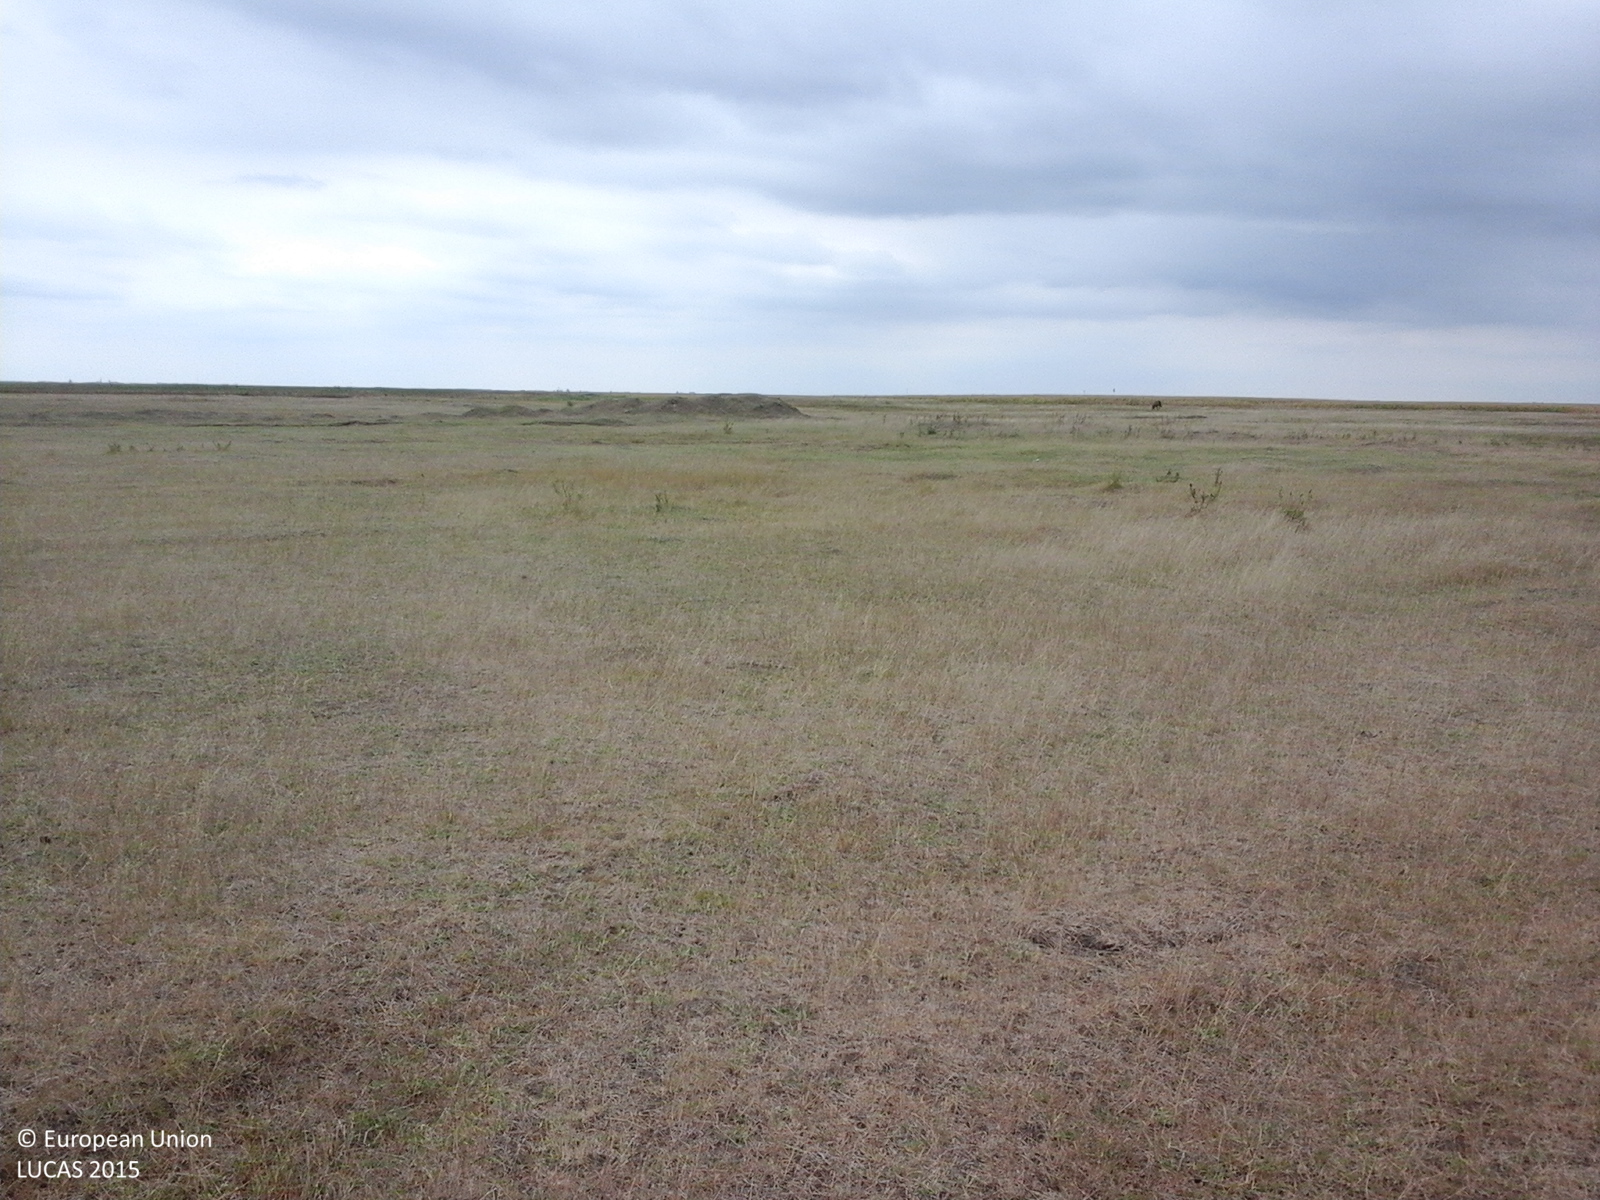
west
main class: Grassland
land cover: Grassland without tree/shrub cover
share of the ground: > 75 %
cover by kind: herbaceous plants 100 %
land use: Agriculture (excluding fallow land and kitchen gardens)
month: August
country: RO
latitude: 45.5125
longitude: 20.9708
